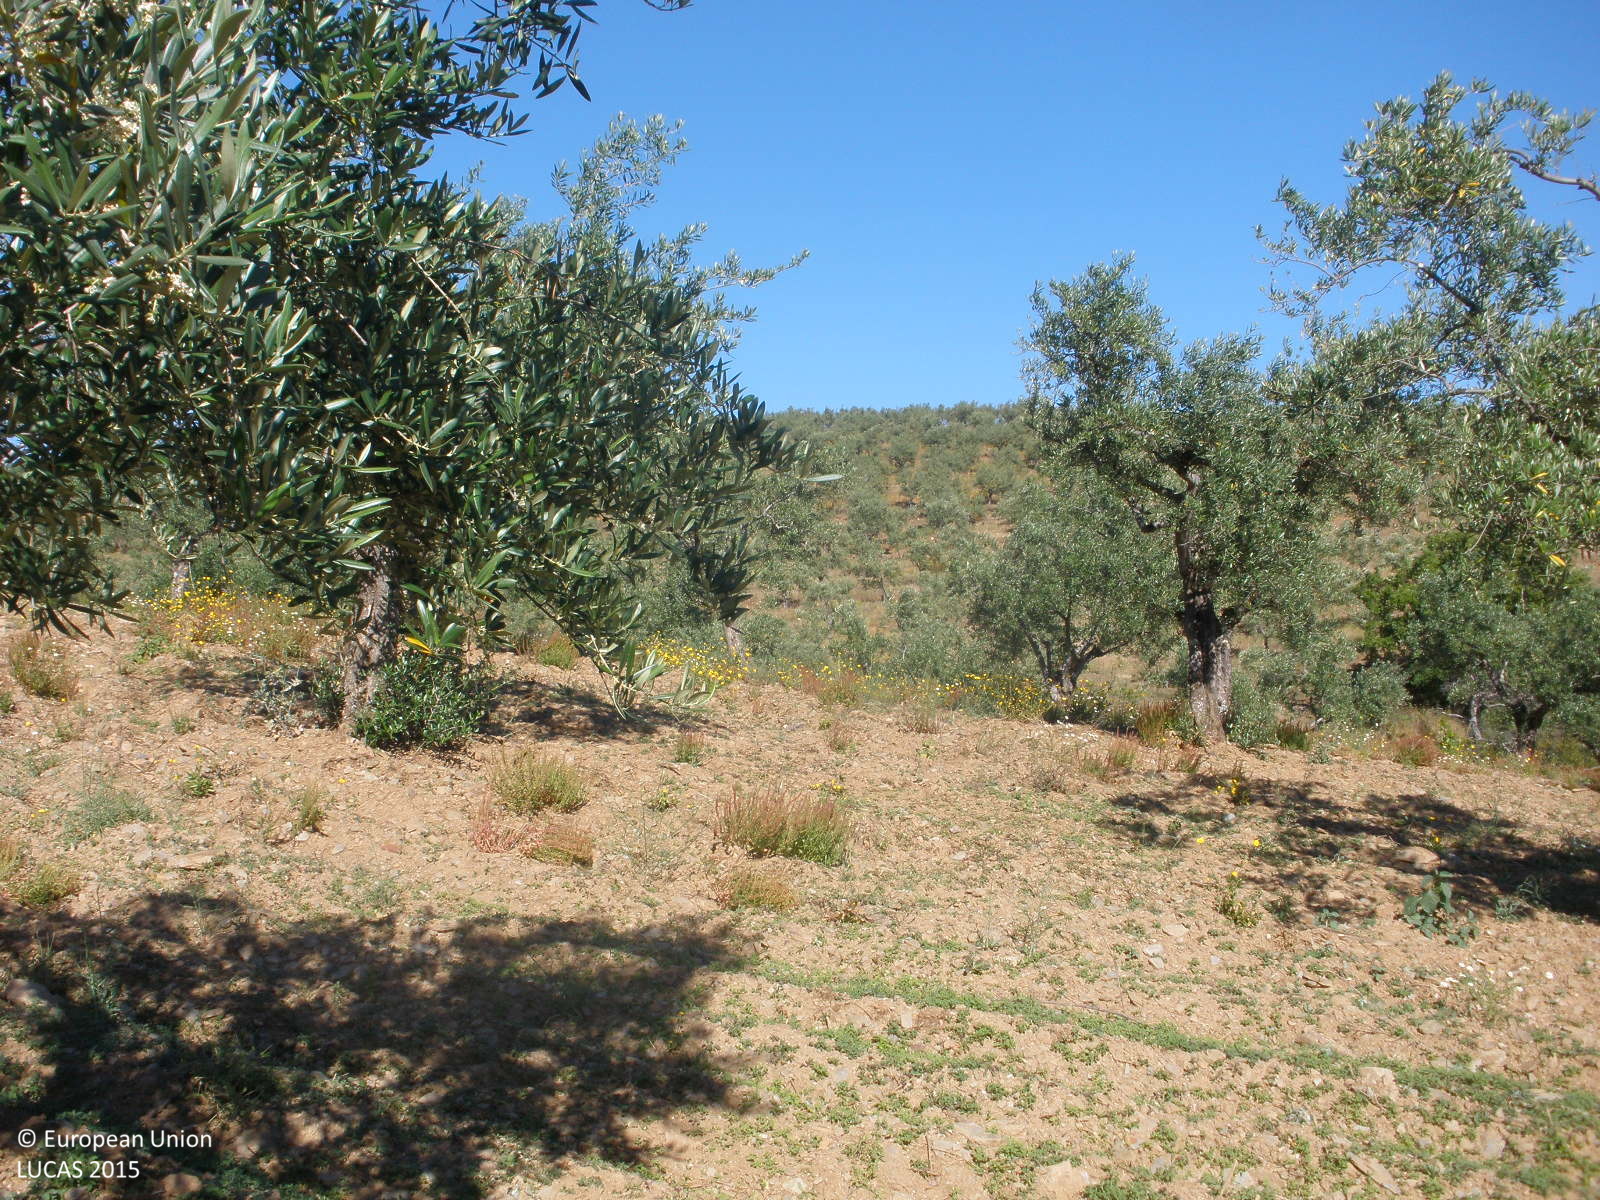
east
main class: Cropland
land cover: Olive groves
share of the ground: 25 - 50 %
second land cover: Spontaneously vegetated surfaces
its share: > 75 %
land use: Agriculture (excluding fallow land and kitchen gardens)
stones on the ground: > 50 %
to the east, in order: Olive groves; Spontaneously vegetated surfaces; Fences; Grassland without tree/shrub cover; Rivers and streams; Dry stone walls; Olive groves; Dry stone walls; Fences; Shruby margins; Tracks; Shrubland without tree cover
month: May
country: ES
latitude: 40.2690
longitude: -6.2238
